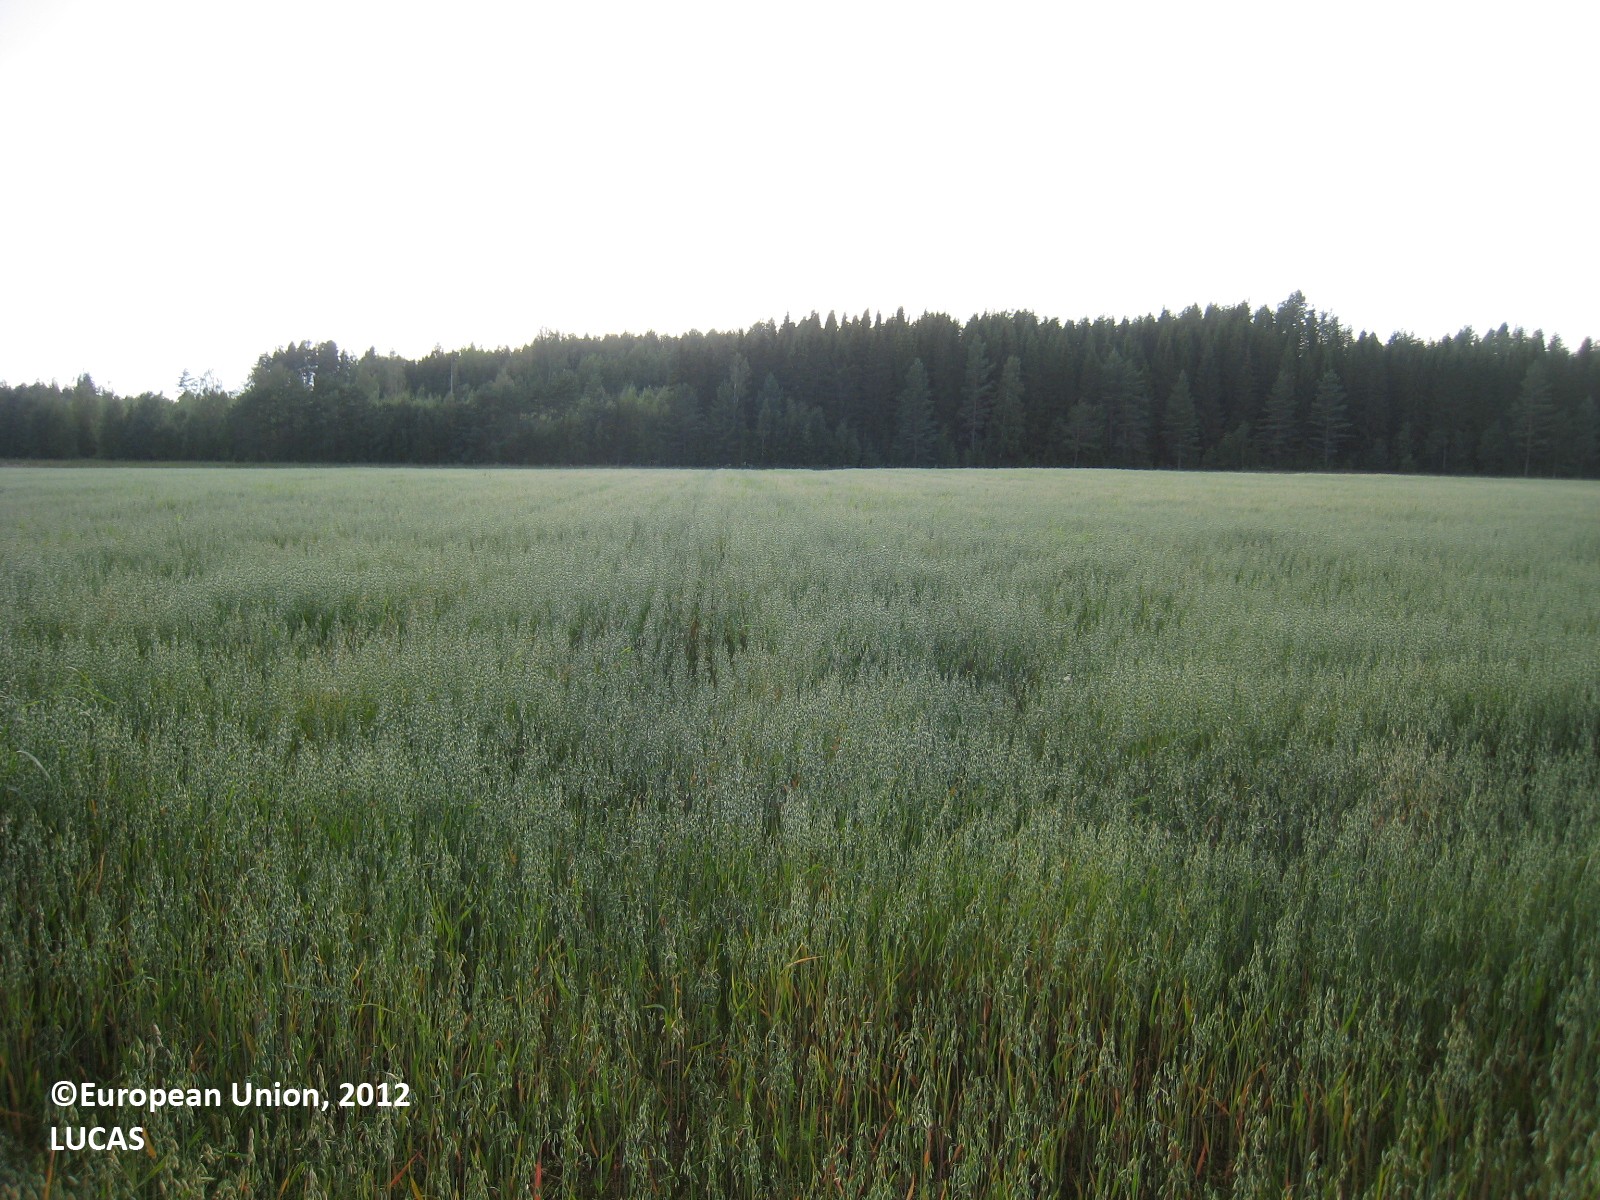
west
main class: Cropland
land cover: Oats
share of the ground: 50 - 75 %
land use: Agriculture (excluding fallow land and kitchen gardens)
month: July
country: FI
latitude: 61.6720
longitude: 26.0201
